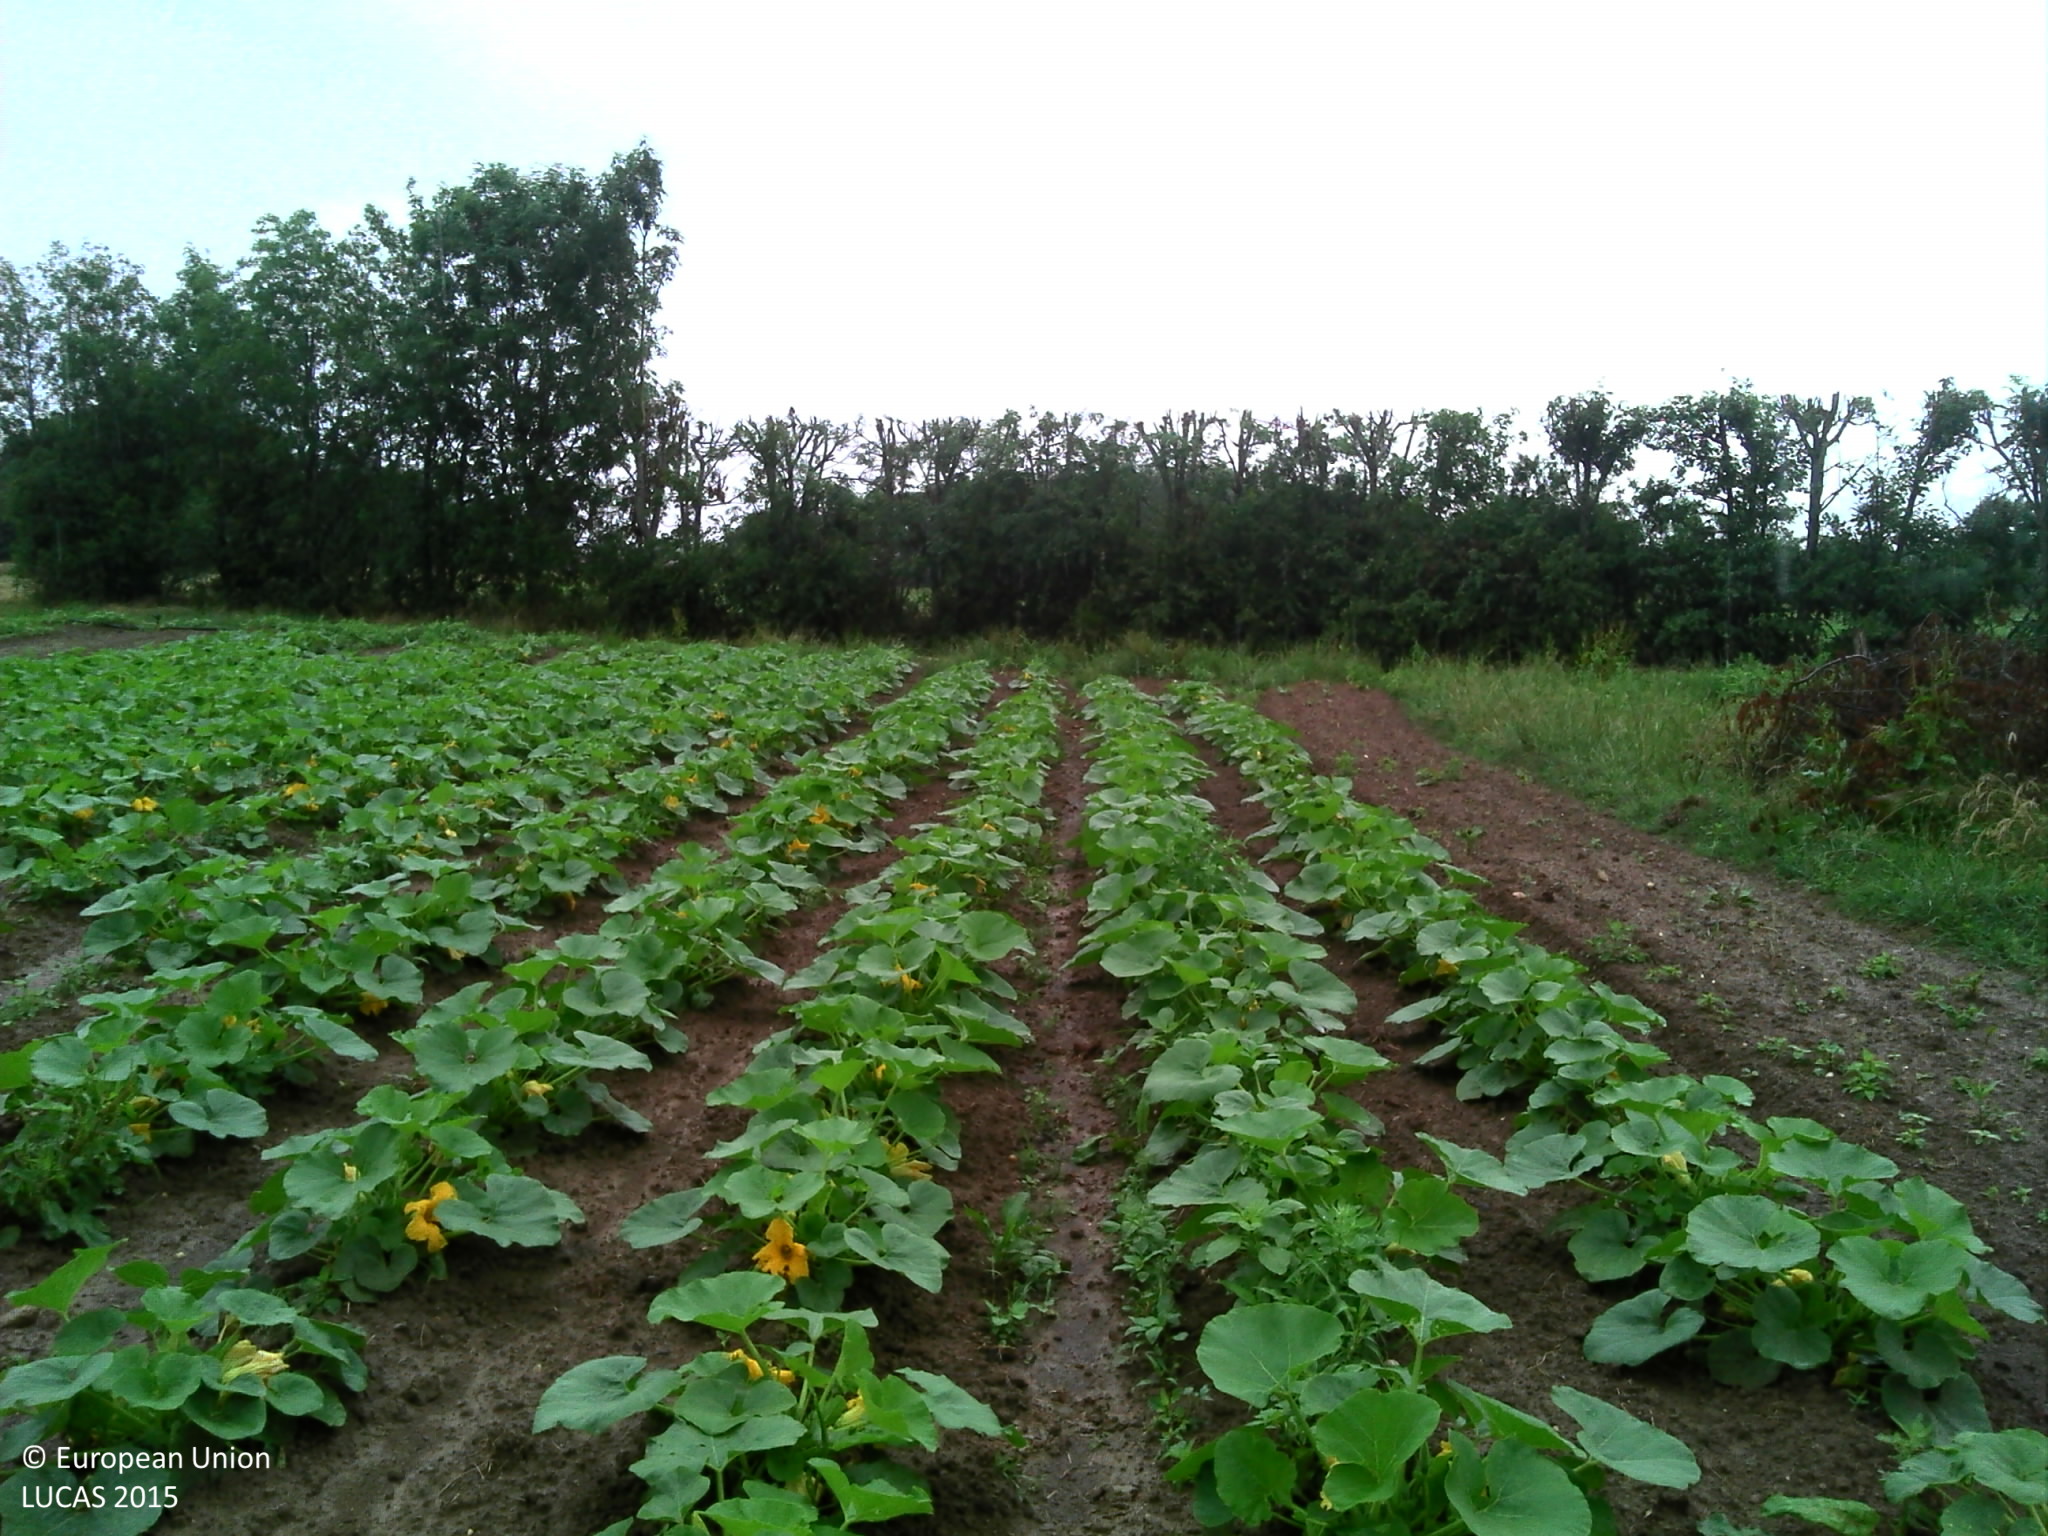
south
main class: Cropland
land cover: Other fresh vegetables
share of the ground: 50 - 75 %
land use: Agriculture (excluding fallow land and kitchen gardens)
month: June
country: FR
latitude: 46.9945
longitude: 5.4650
